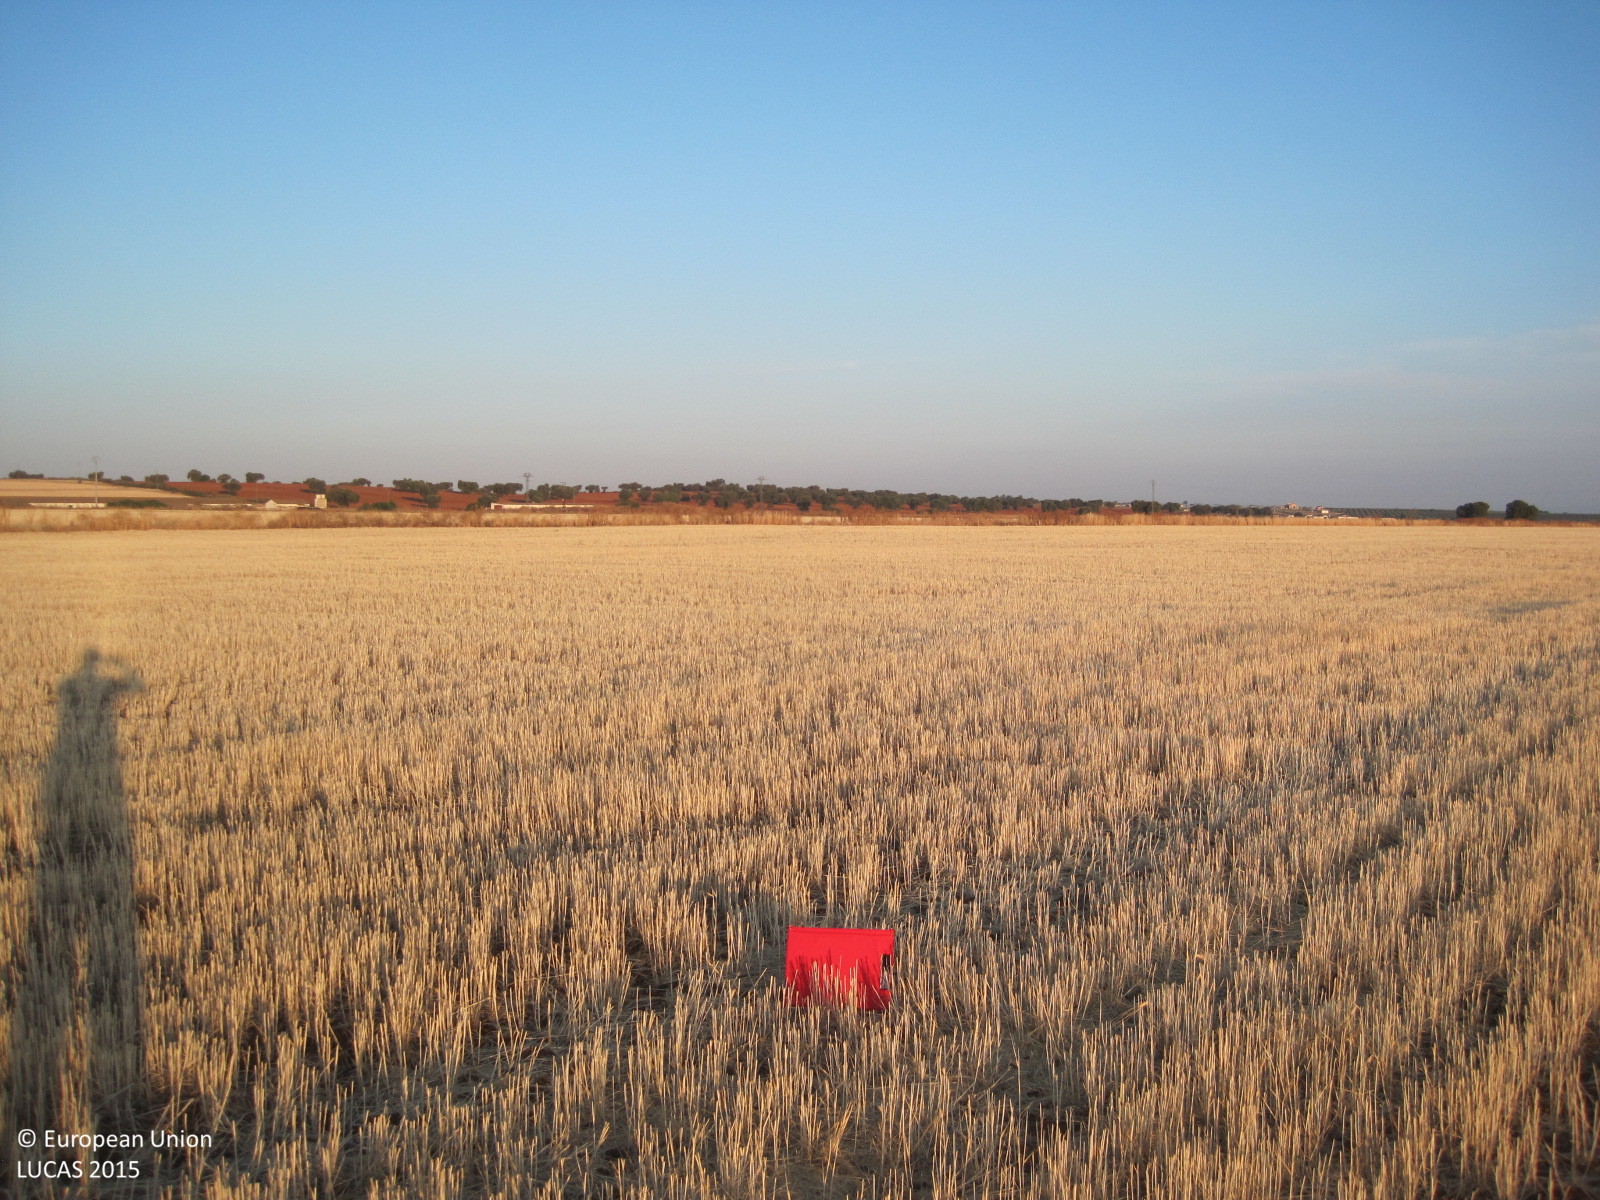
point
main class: Cropland
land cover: Barley
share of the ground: < 10 %
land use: Agriculture (excluding fallow land and kitchen gardens)
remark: Harvested field
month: June
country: ES
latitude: 39.8559
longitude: -4.6663
